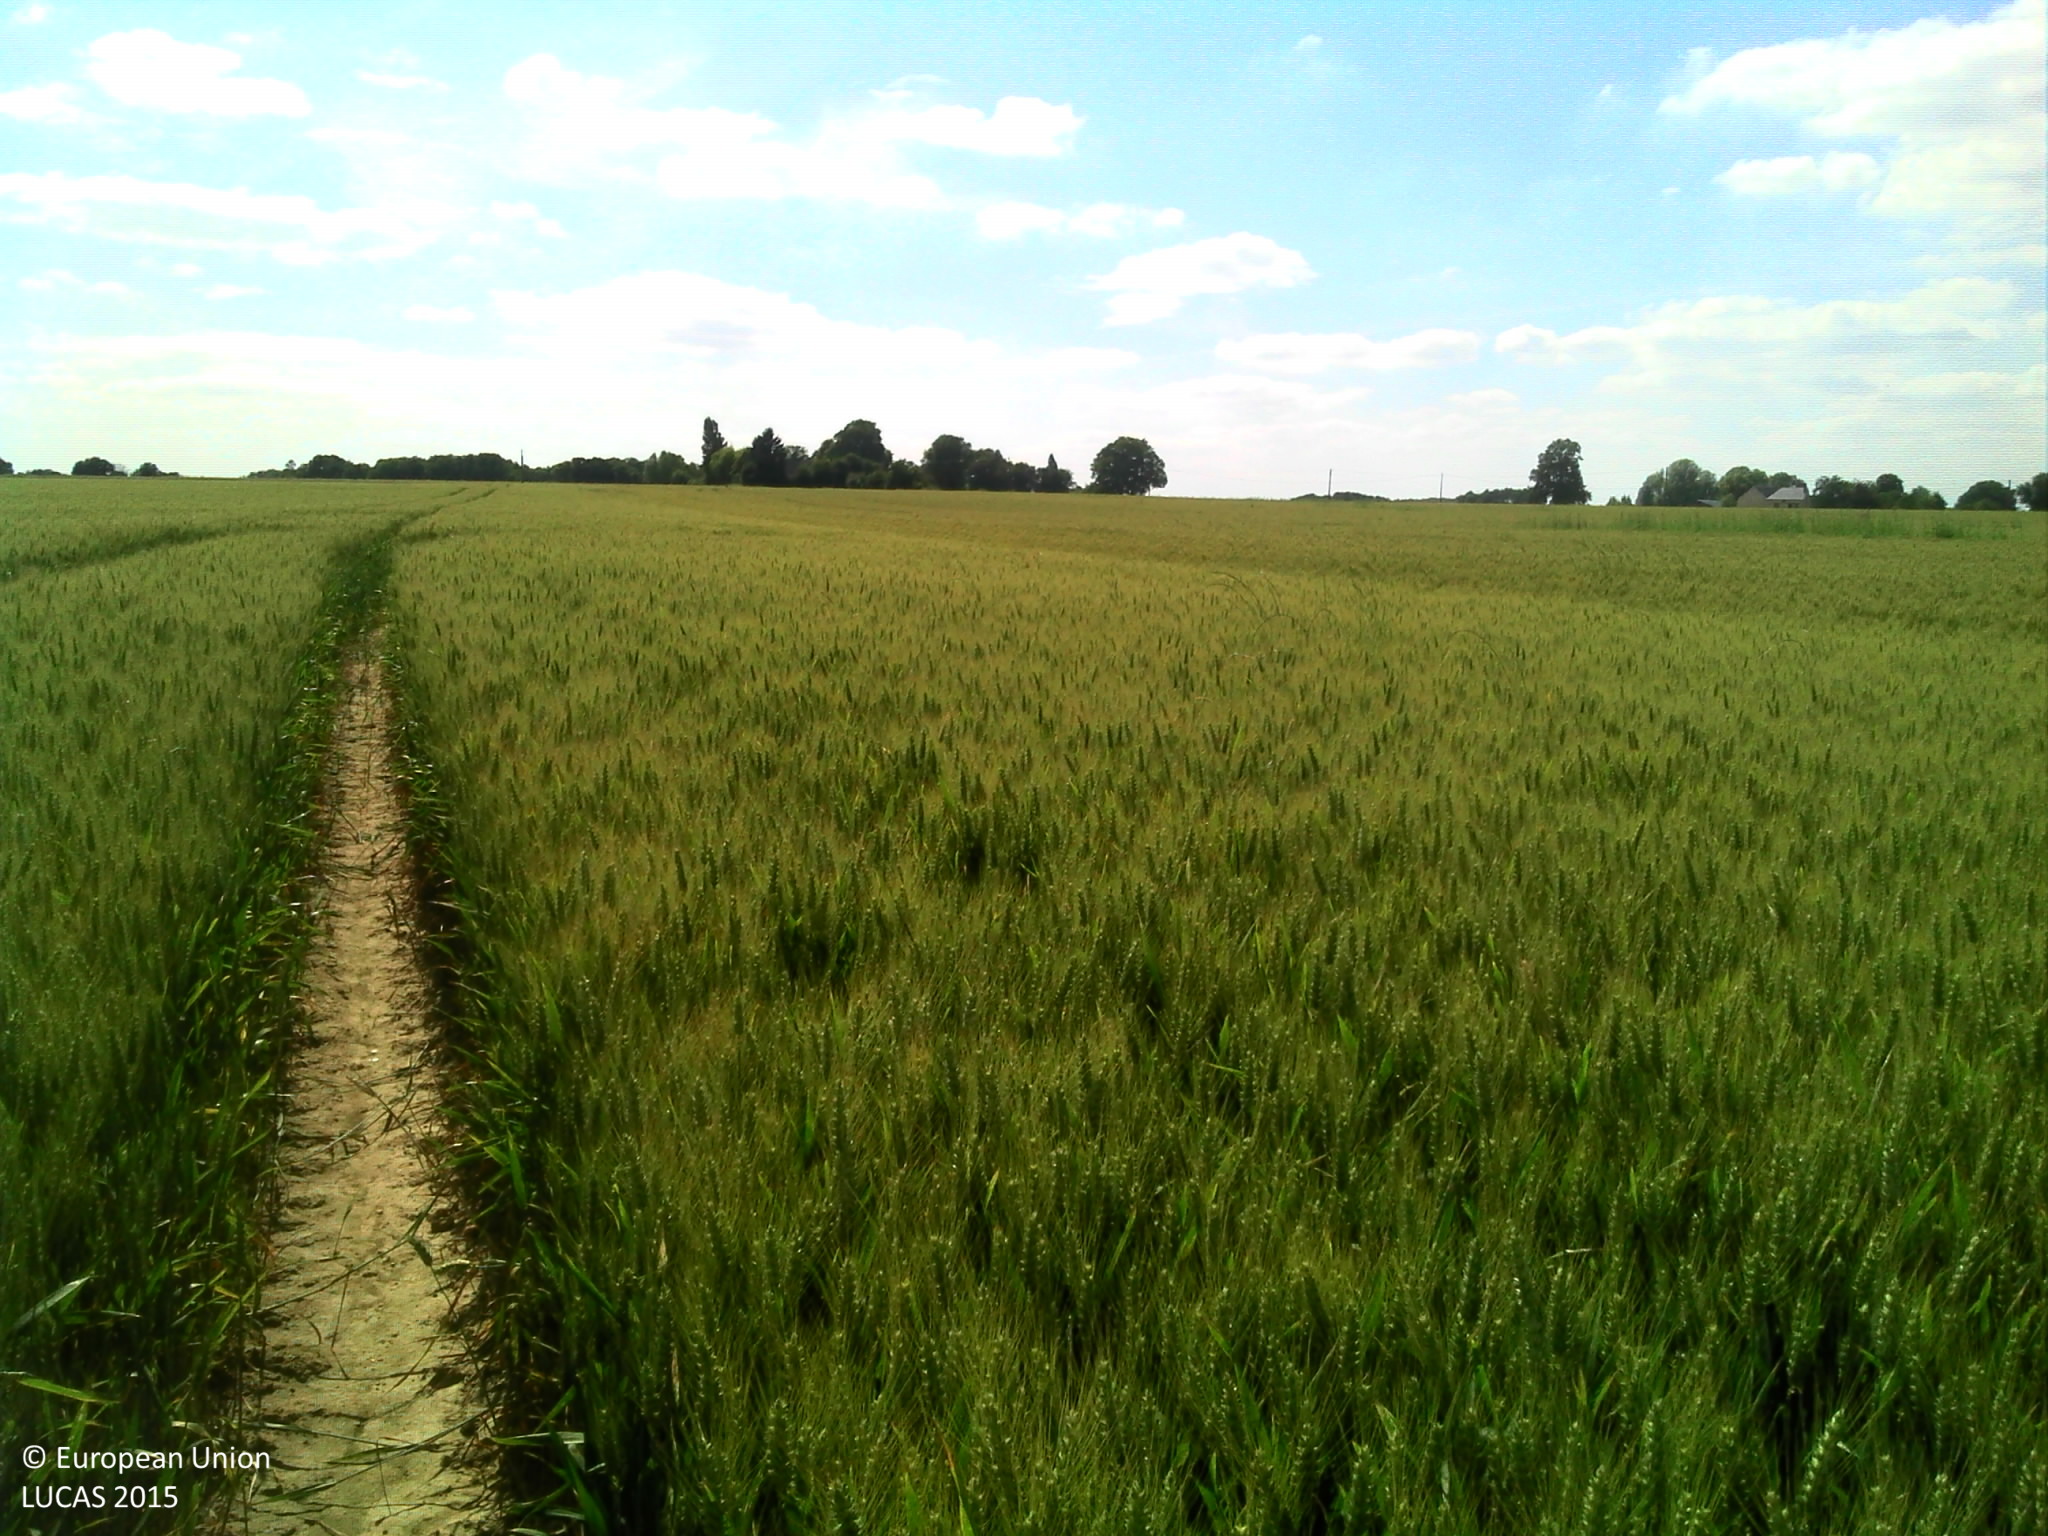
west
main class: Cropland
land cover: Durum wheat
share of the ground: > 75 %
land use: Agriculture (excluding fallow land and kitchen gardens)
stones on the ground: < 10 %
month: June
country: FR
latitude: 47.5567
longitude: 0.4761
